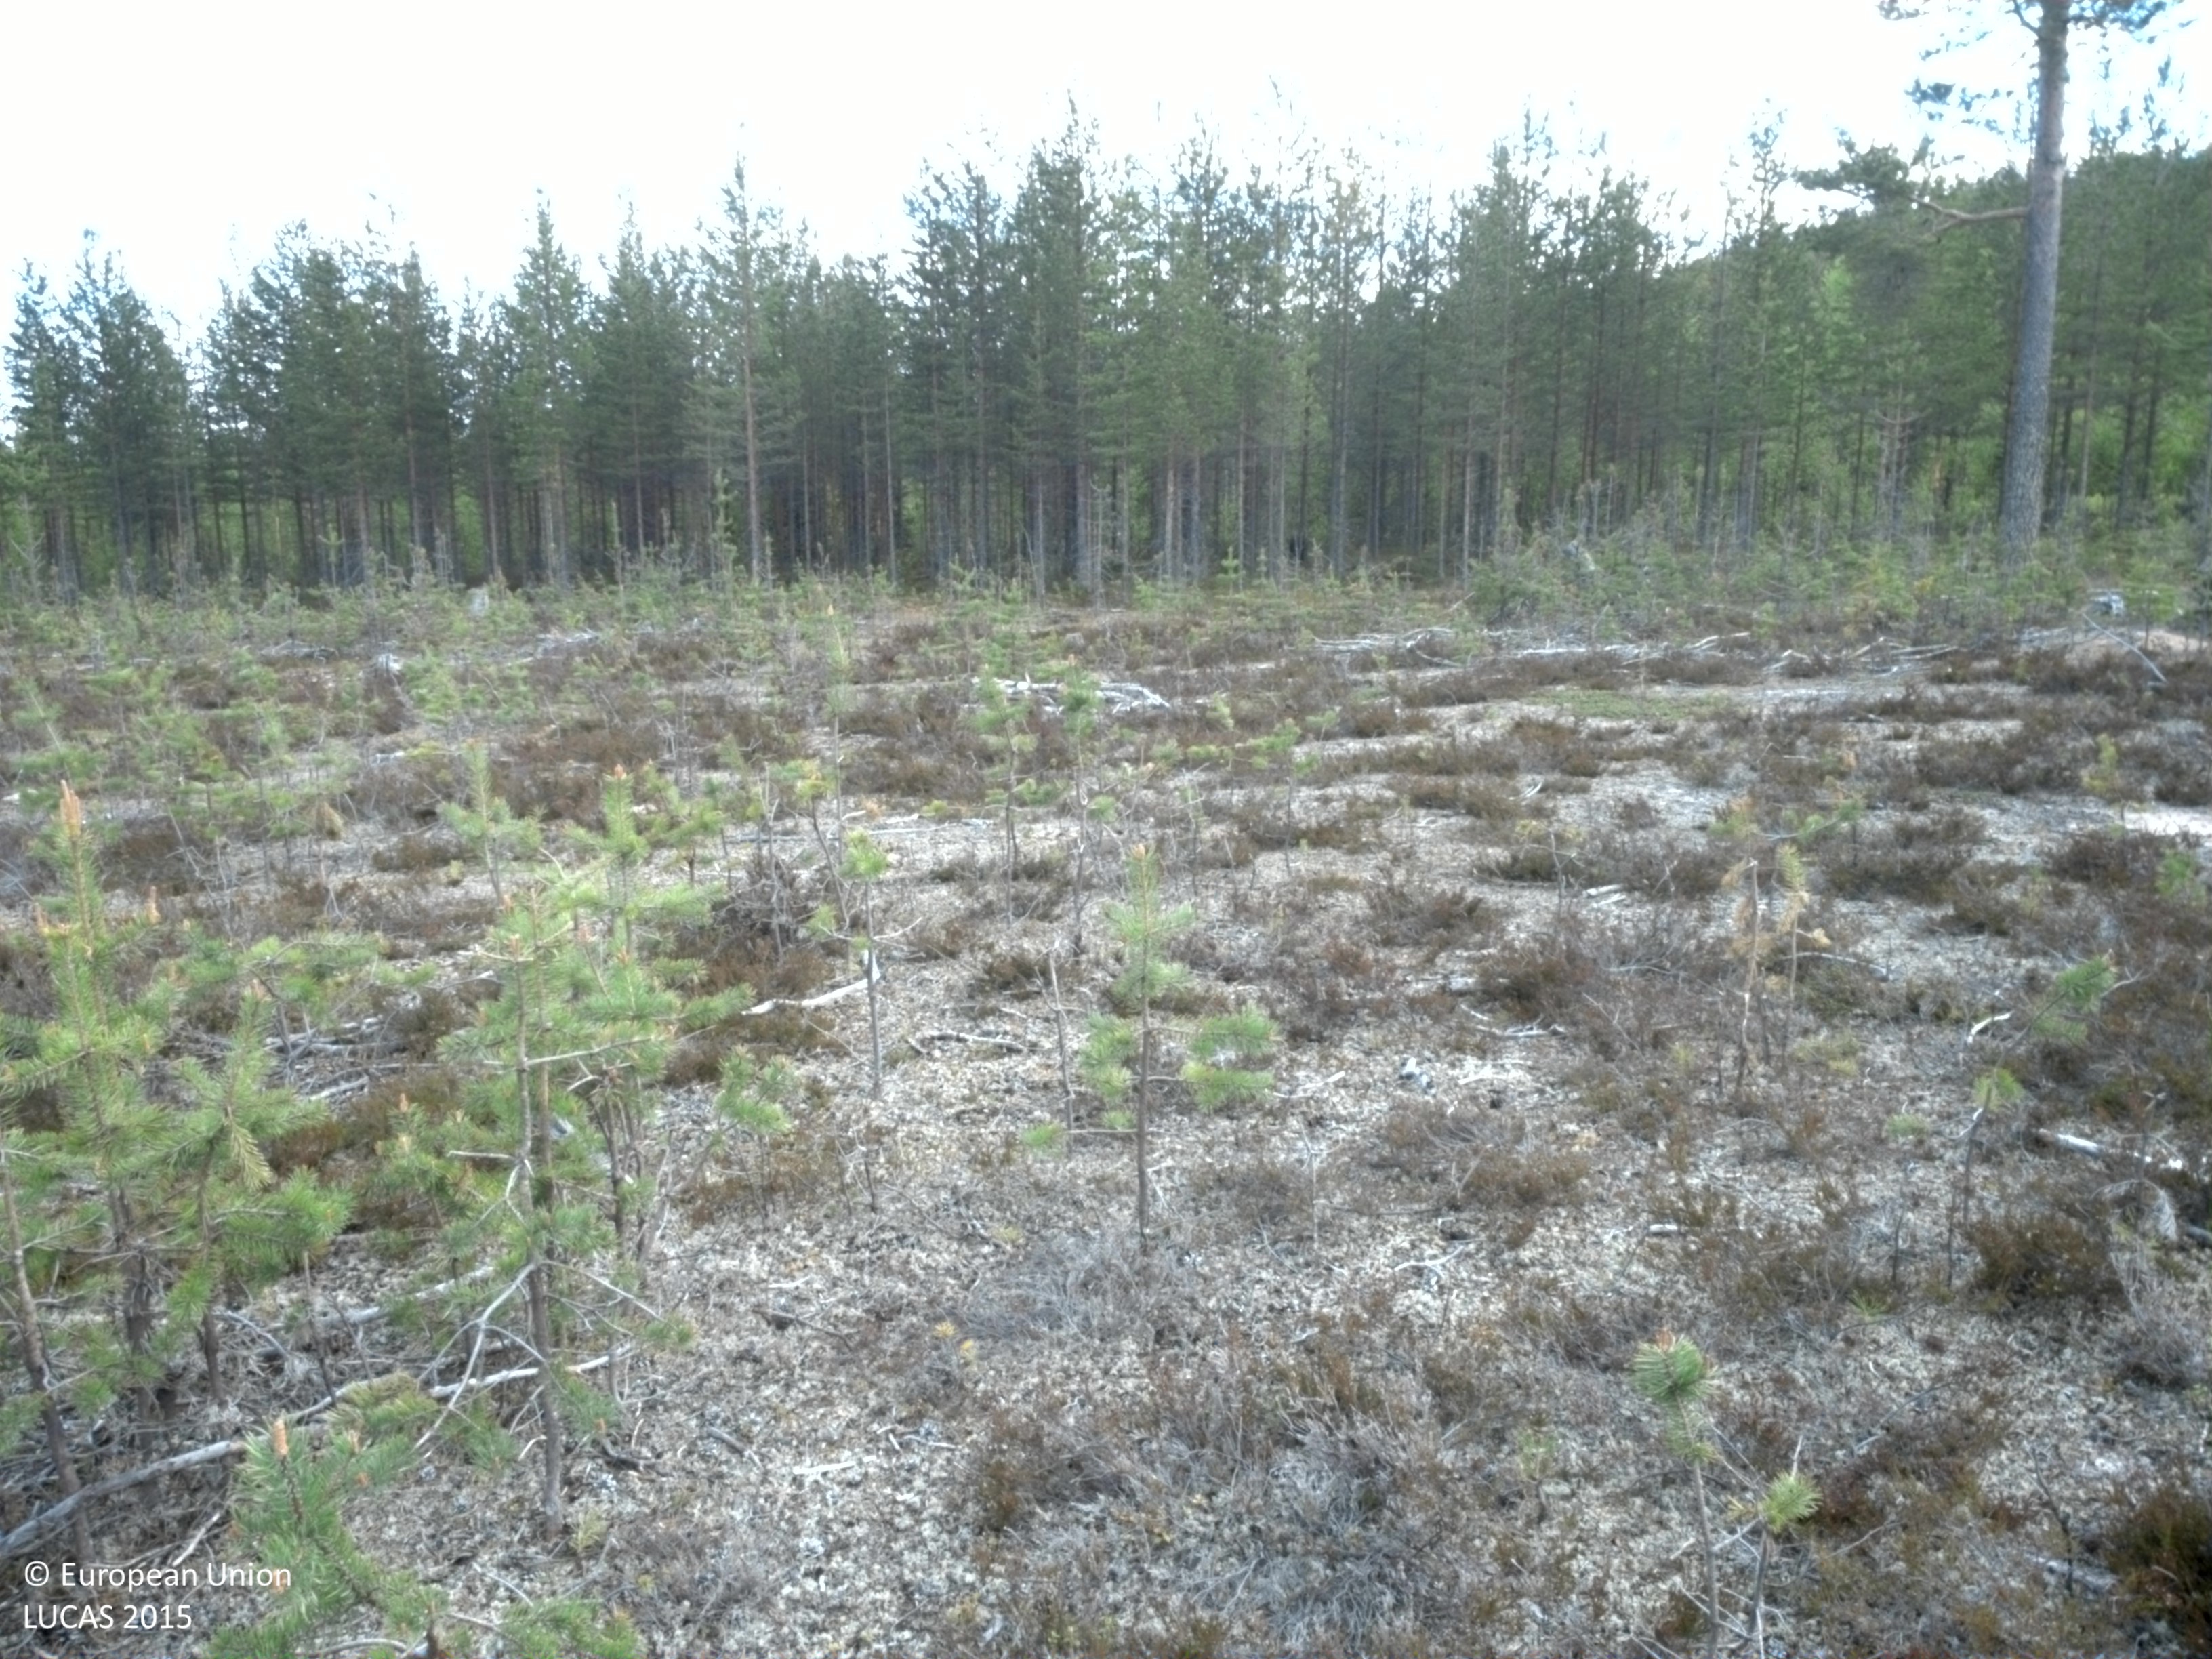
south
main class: Woodland
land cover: Pine dominated coniferous woodland
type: boreal forest
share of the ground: 10 - 25 %
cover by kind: shrubs 50 %, lichens and mosses 35 %, coniferous forest trees 15 %
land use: Forestry
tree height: < 5 m
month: June
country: SE
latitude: 66.4844
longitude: 22.5727
